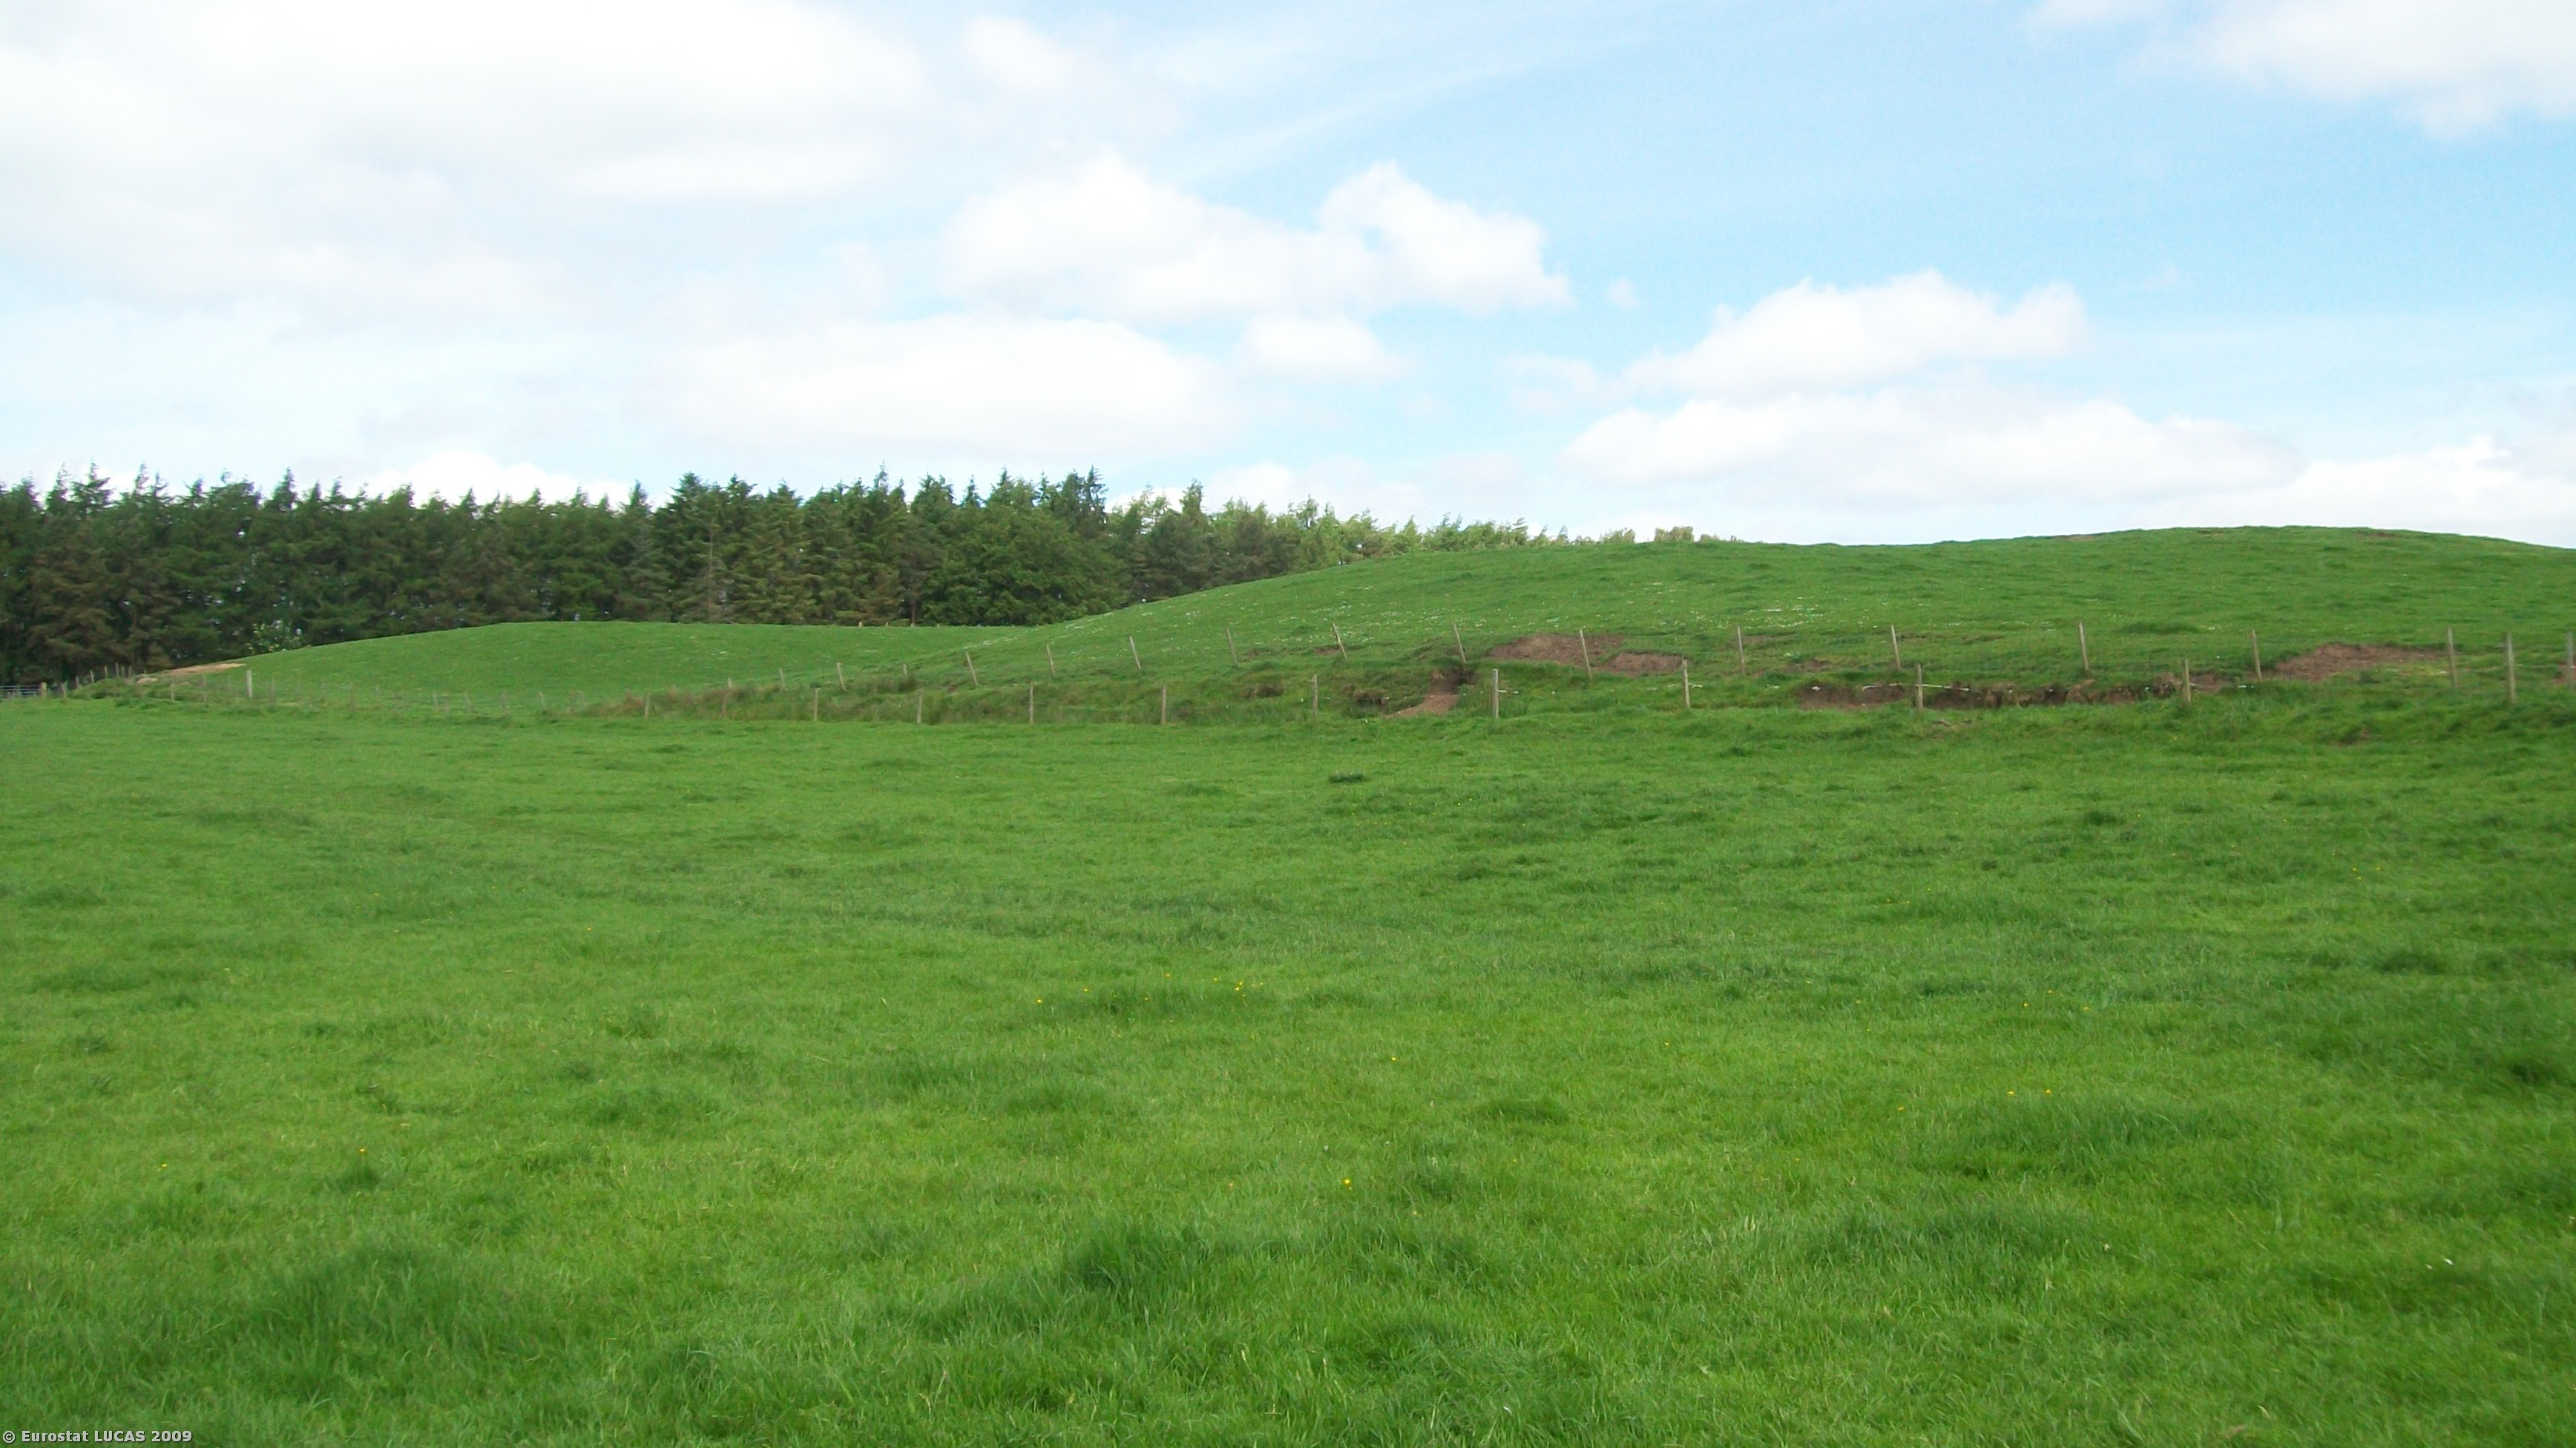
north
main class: Grassland
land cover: Grassland without tree/shrub cover
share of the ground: > 75 %
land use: Agriculture (excluding fallow land and kitchen gardens)
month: June
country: GB
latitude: 55.6978
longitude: -3.5882
